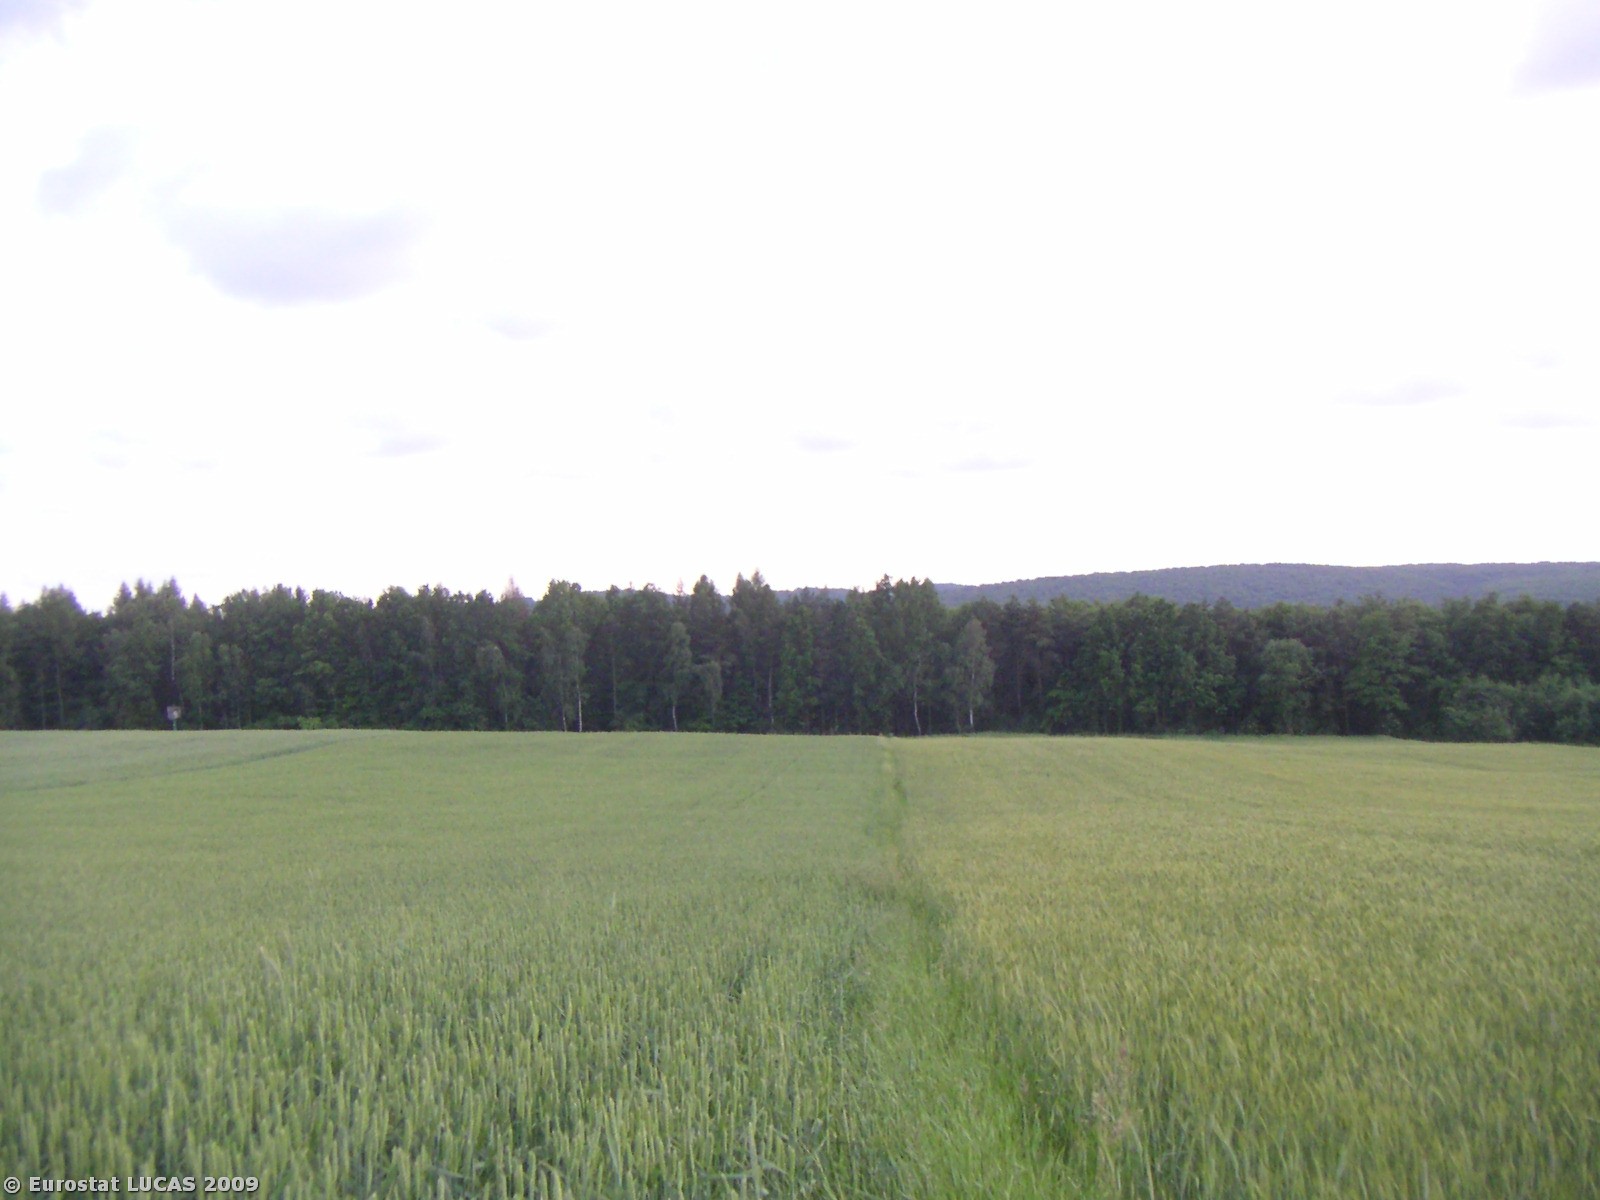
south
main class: Cropland
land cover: Common wheat
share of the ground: > 75 %
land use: Agriculture (excluding fallow land and kitchen gardens)
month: June
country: PL
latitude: 50.3483
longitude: 19.7122
